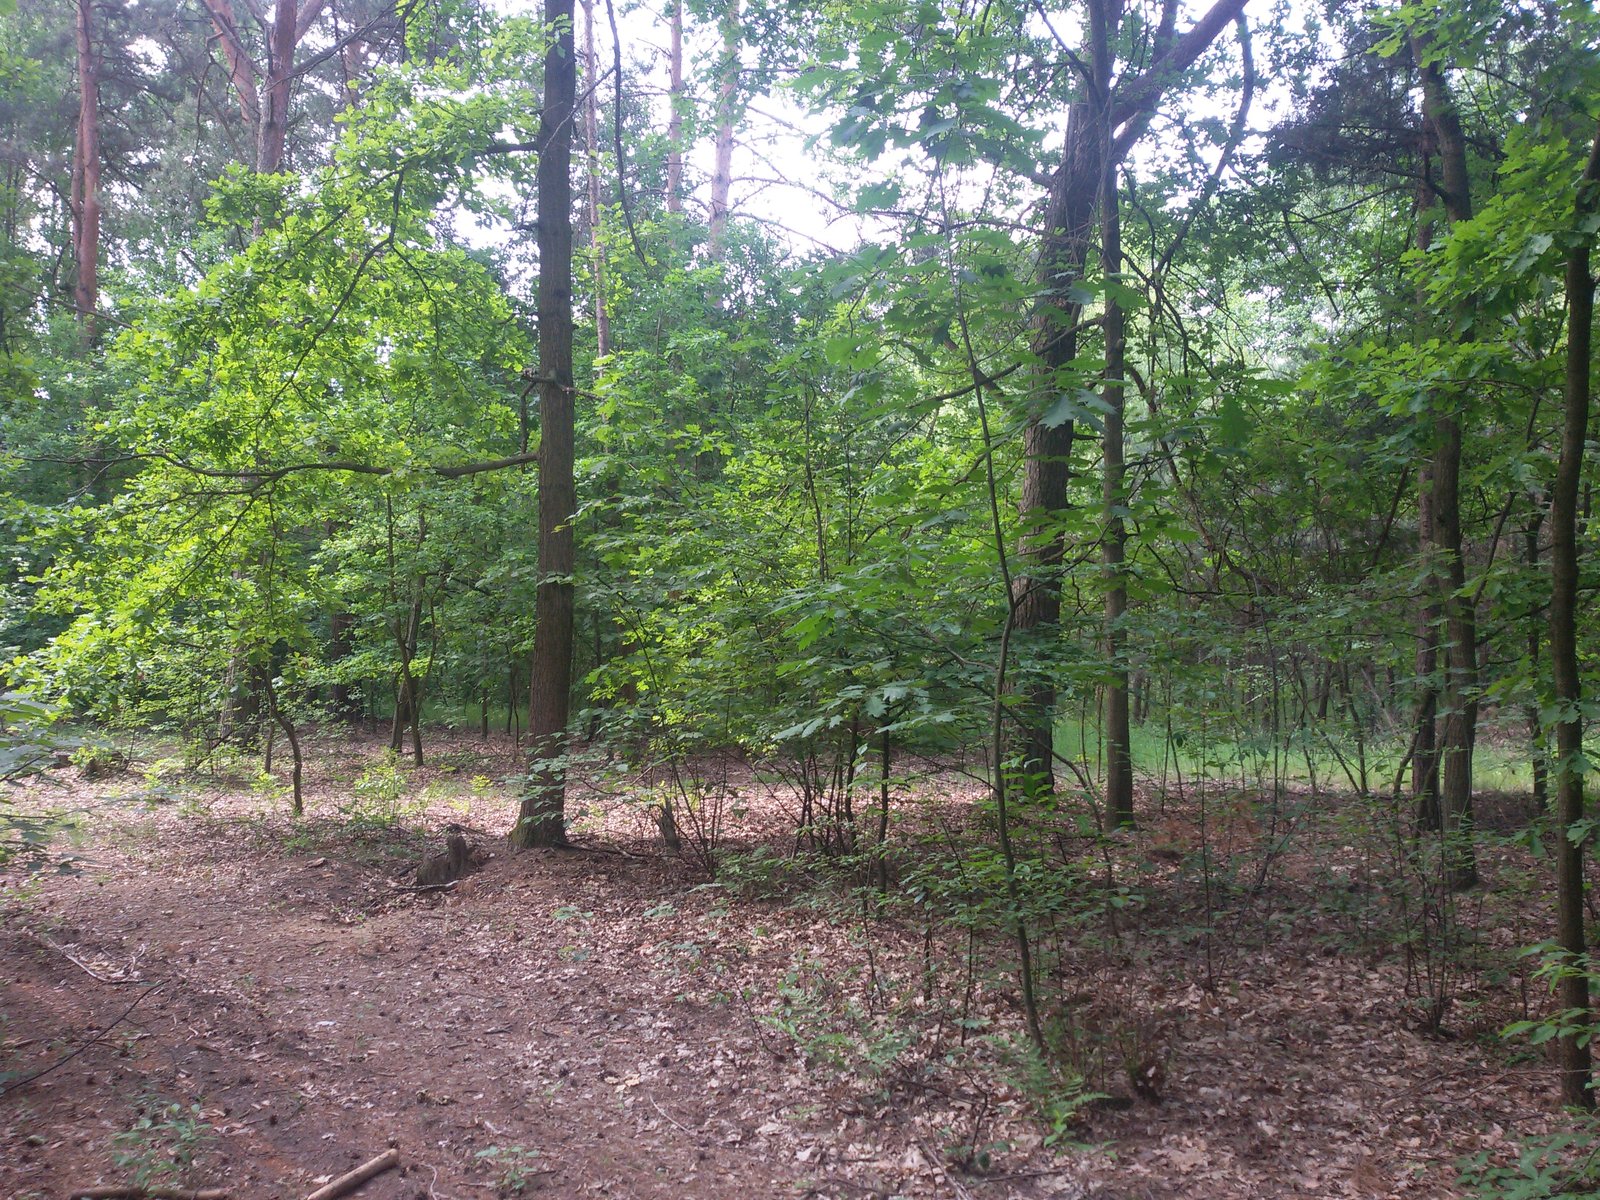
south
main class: Woodland
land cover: Other mixed woodland
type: hemiboreal forest and nemoral coniferous forest and mixed broadleaved-coniferous forest
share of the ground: > 75 %
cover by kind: broadleaved forest trees 55 %, coniferous forest trees 20 %, herbaceous plants 10 %, shrubs 5 %, lichens and mosses 5 %
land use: Forestry
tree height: > 5 m
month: June
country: PL
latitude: 50.1505
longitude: 21.6259
